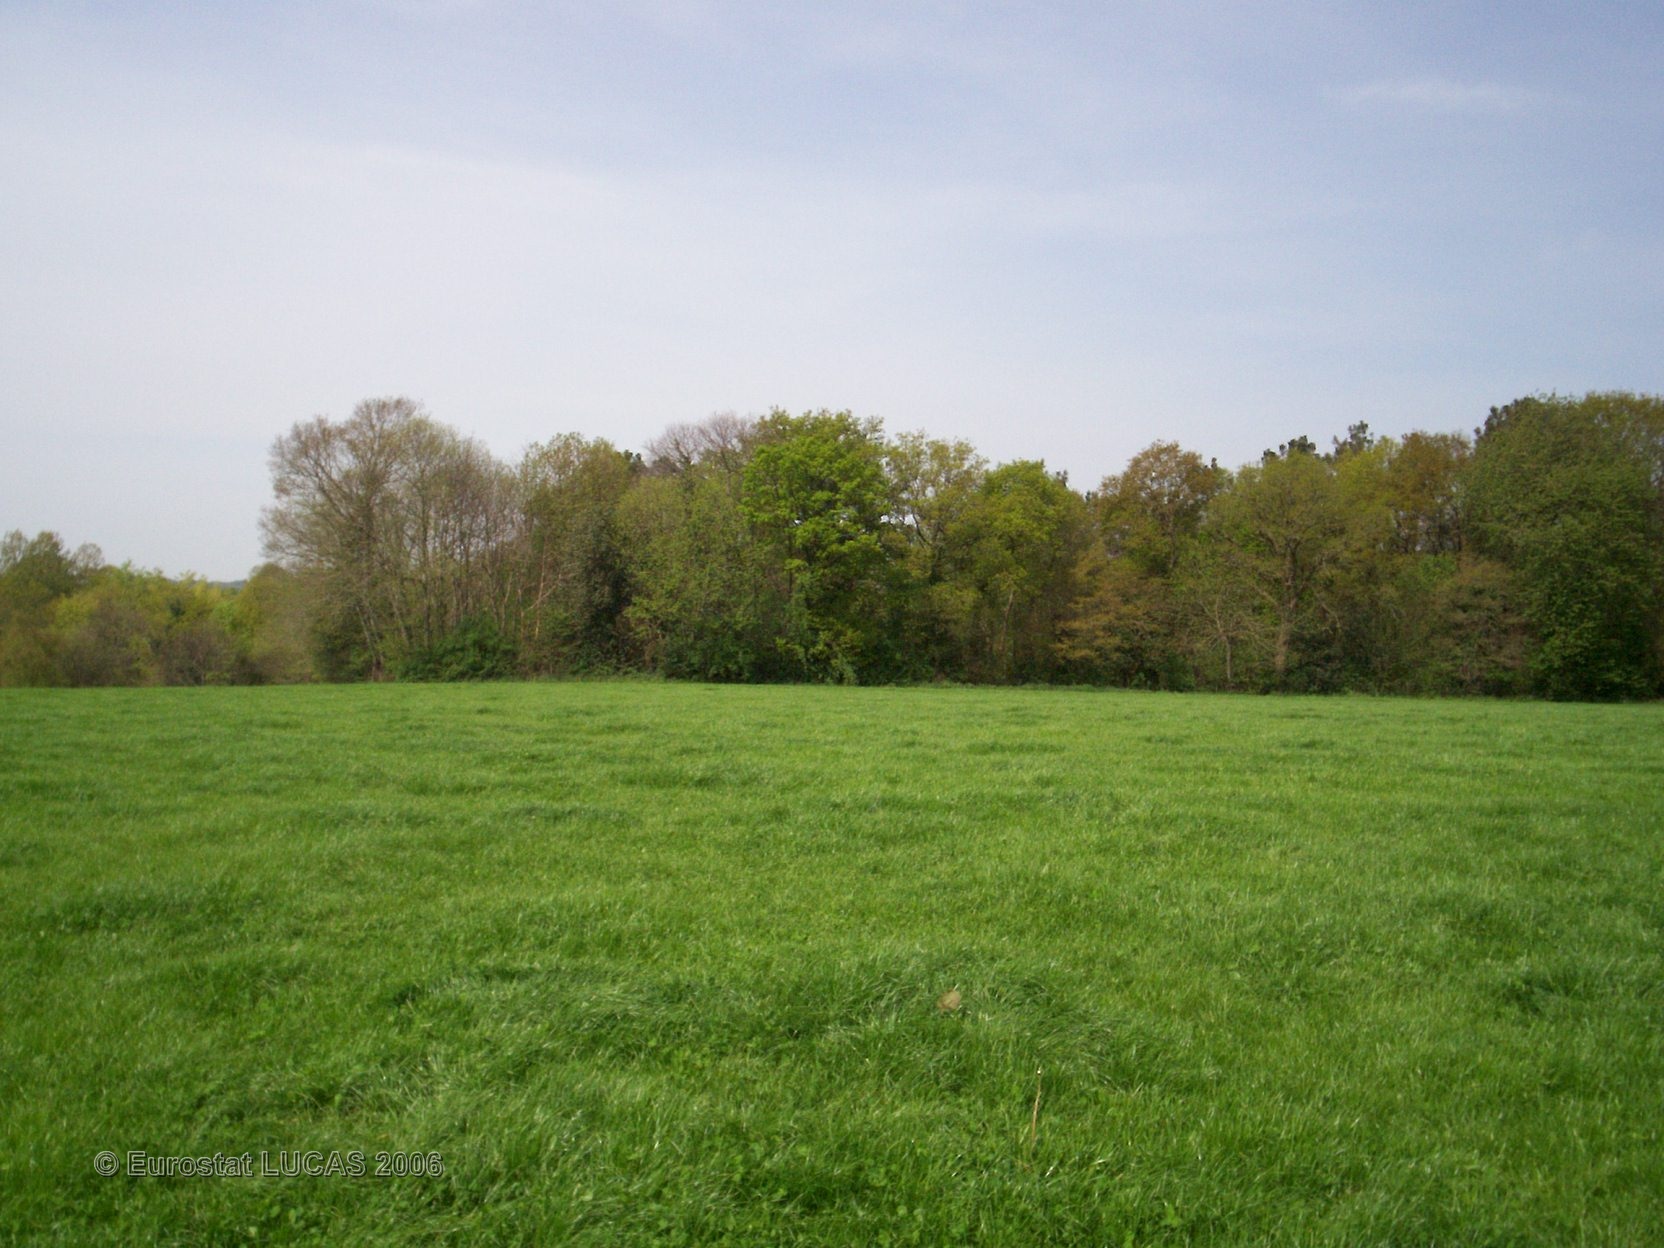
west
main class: Grassland
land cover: Grassland without tree/shrub cover
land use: Agriculture (excluding fallow land and kitchen gardens)
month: May
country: FR
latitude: 47.7132
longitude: -2.3046
